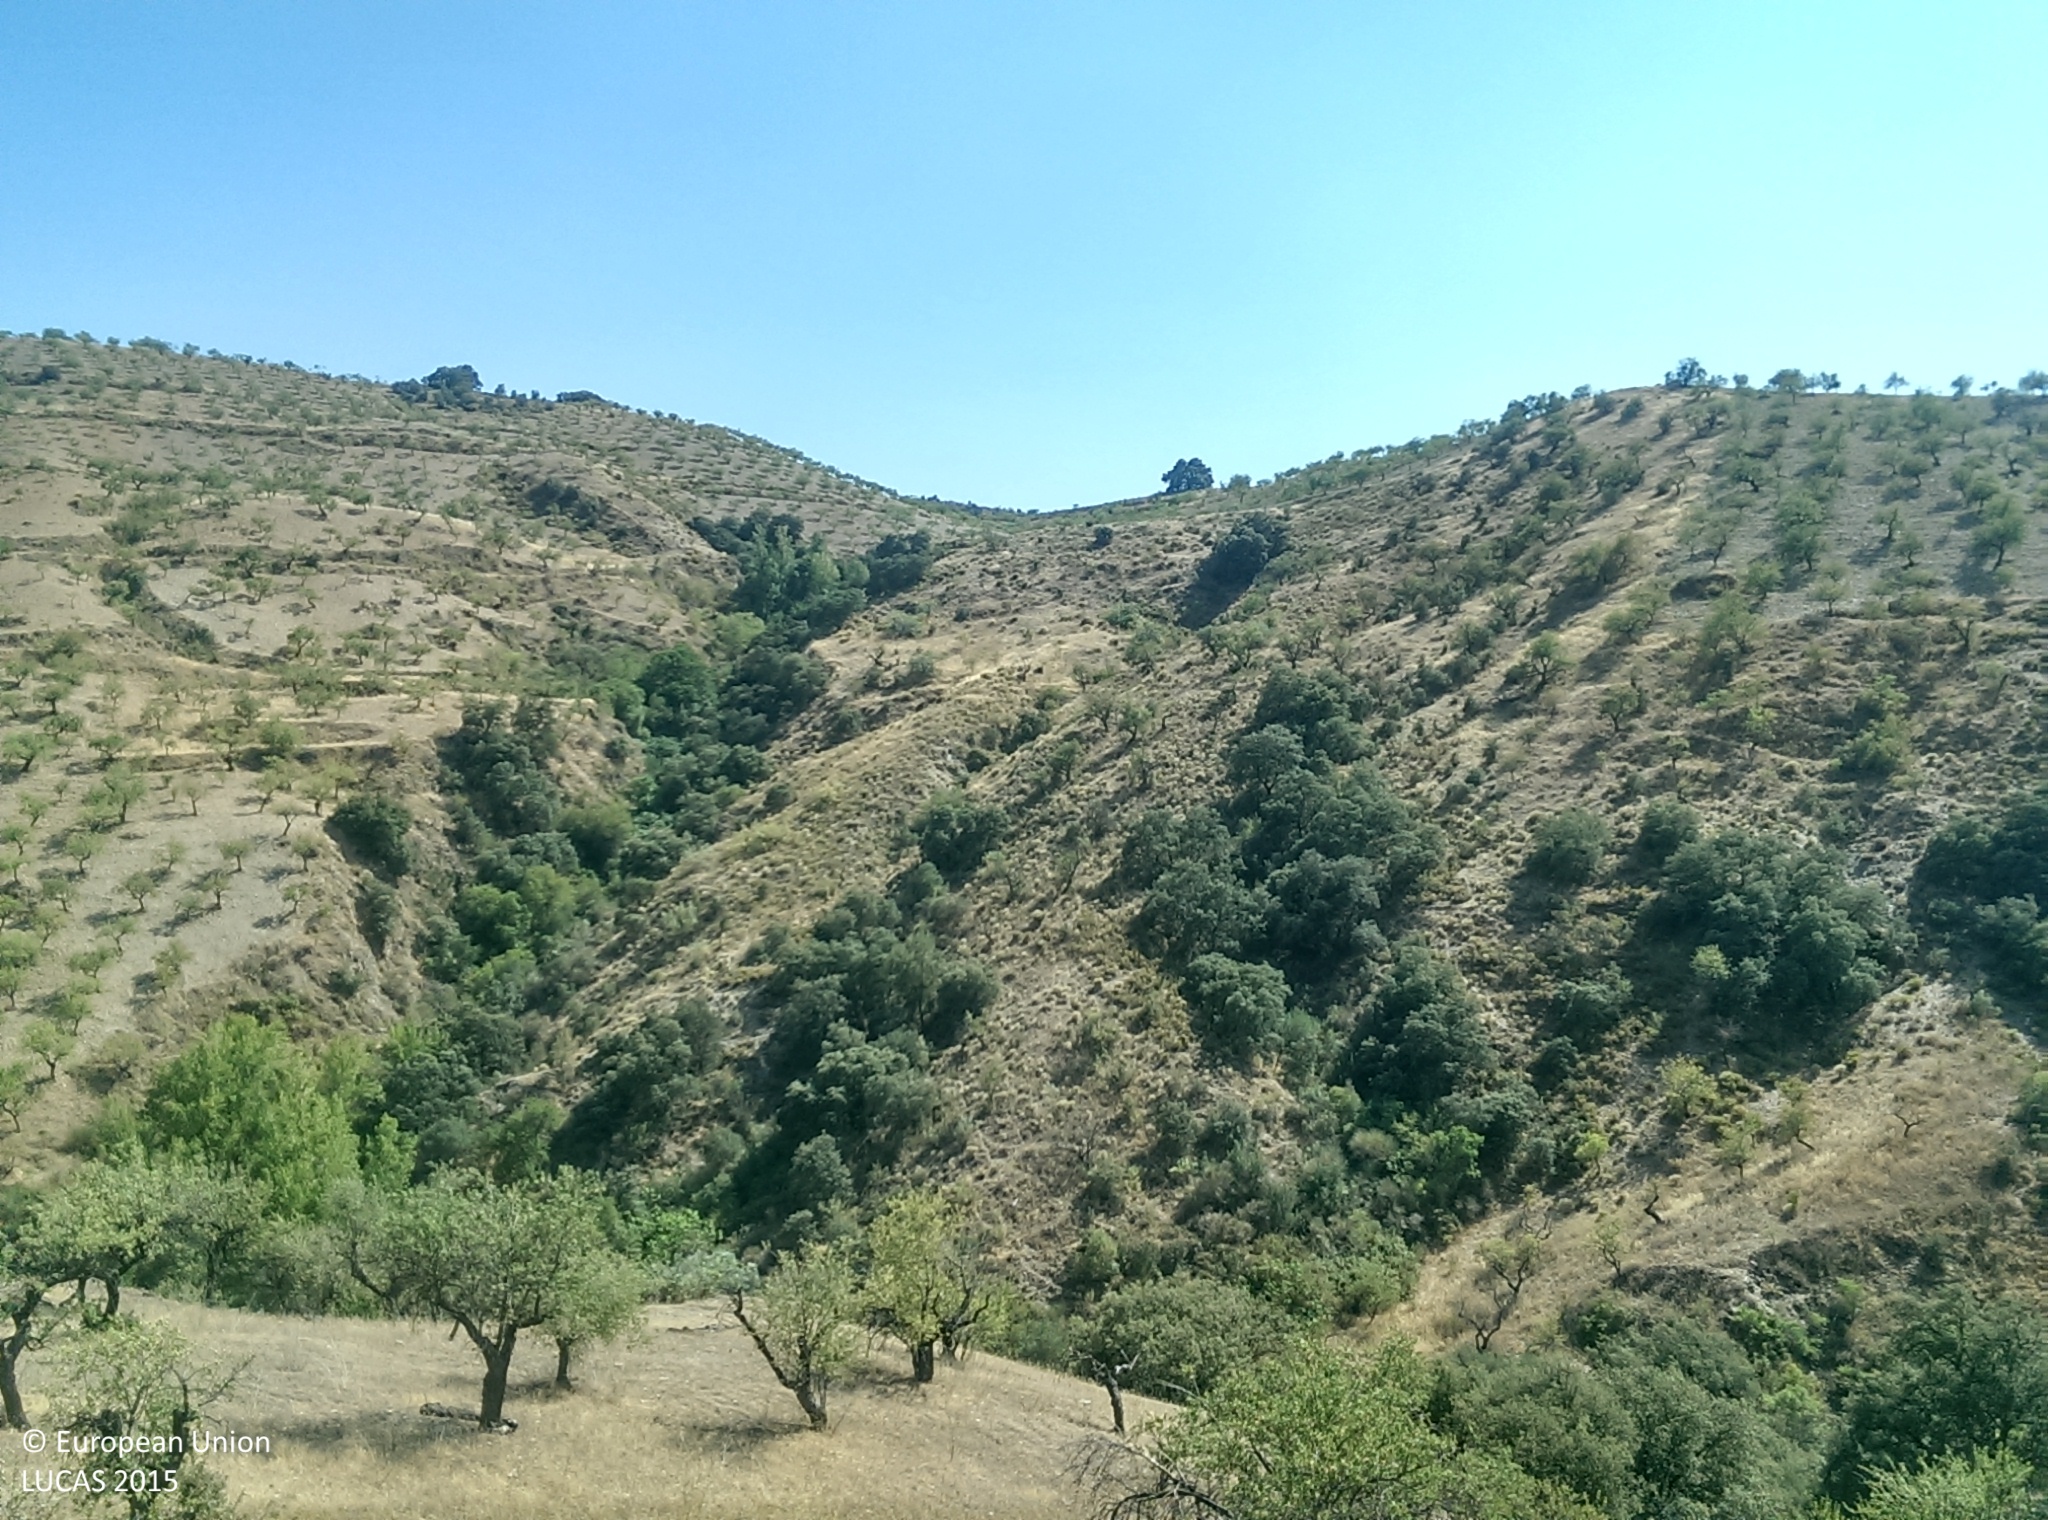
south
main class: Cropland
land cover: Nuts trees
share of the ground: 25 - 50 %
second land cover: Spontaneously vegetated surfaces
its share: 50 - 75 %
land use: Agriculture (excluding fallow land and kitchen gardens)
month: July
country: ES
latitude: 36.9220
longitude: -3.1488
